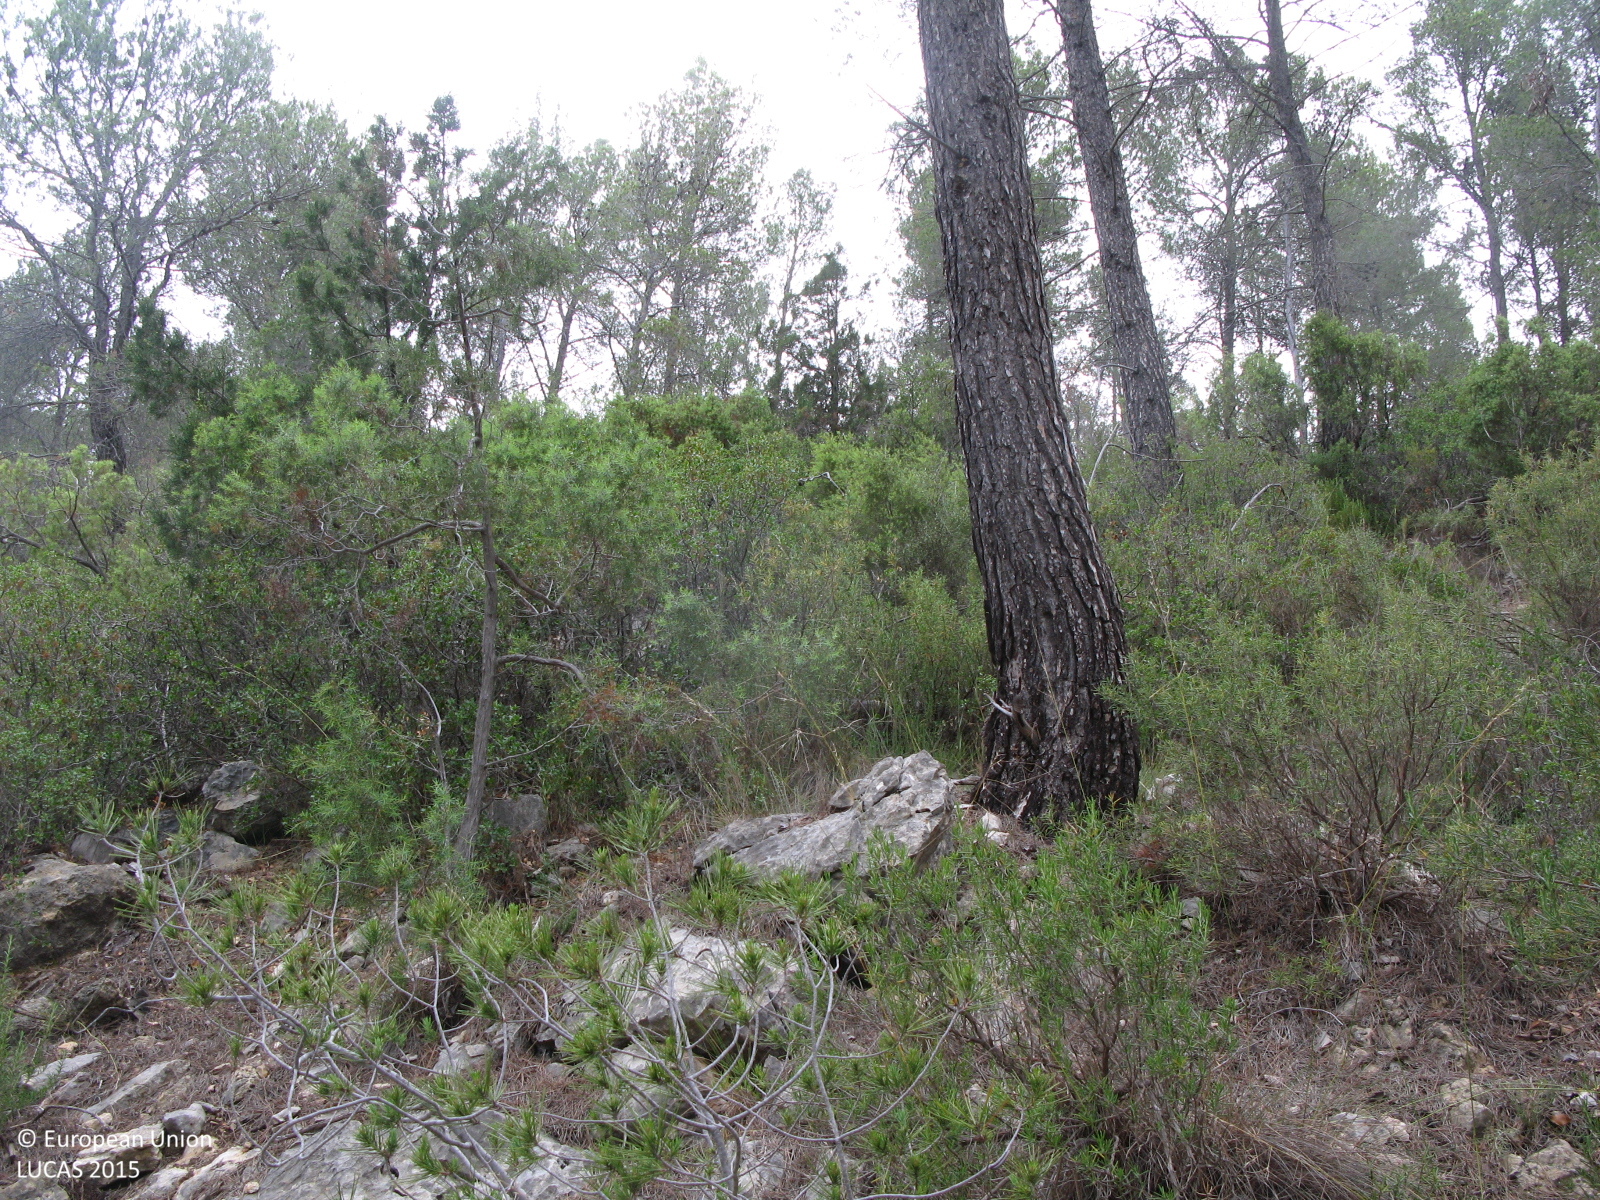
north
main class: Woodland
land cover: Pine dominated coniferous woodland
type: coniferous forest of the mediterranean region
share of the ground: 50 - 75 %
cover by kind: coniferous forest trees 50 %, shrubs 30 %, herbaceous plants 15 %, consolidated bare surface 5 %
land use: Forestry
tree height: > 5 m
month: June
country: ES
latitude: 39.8852
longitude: -1.1501
